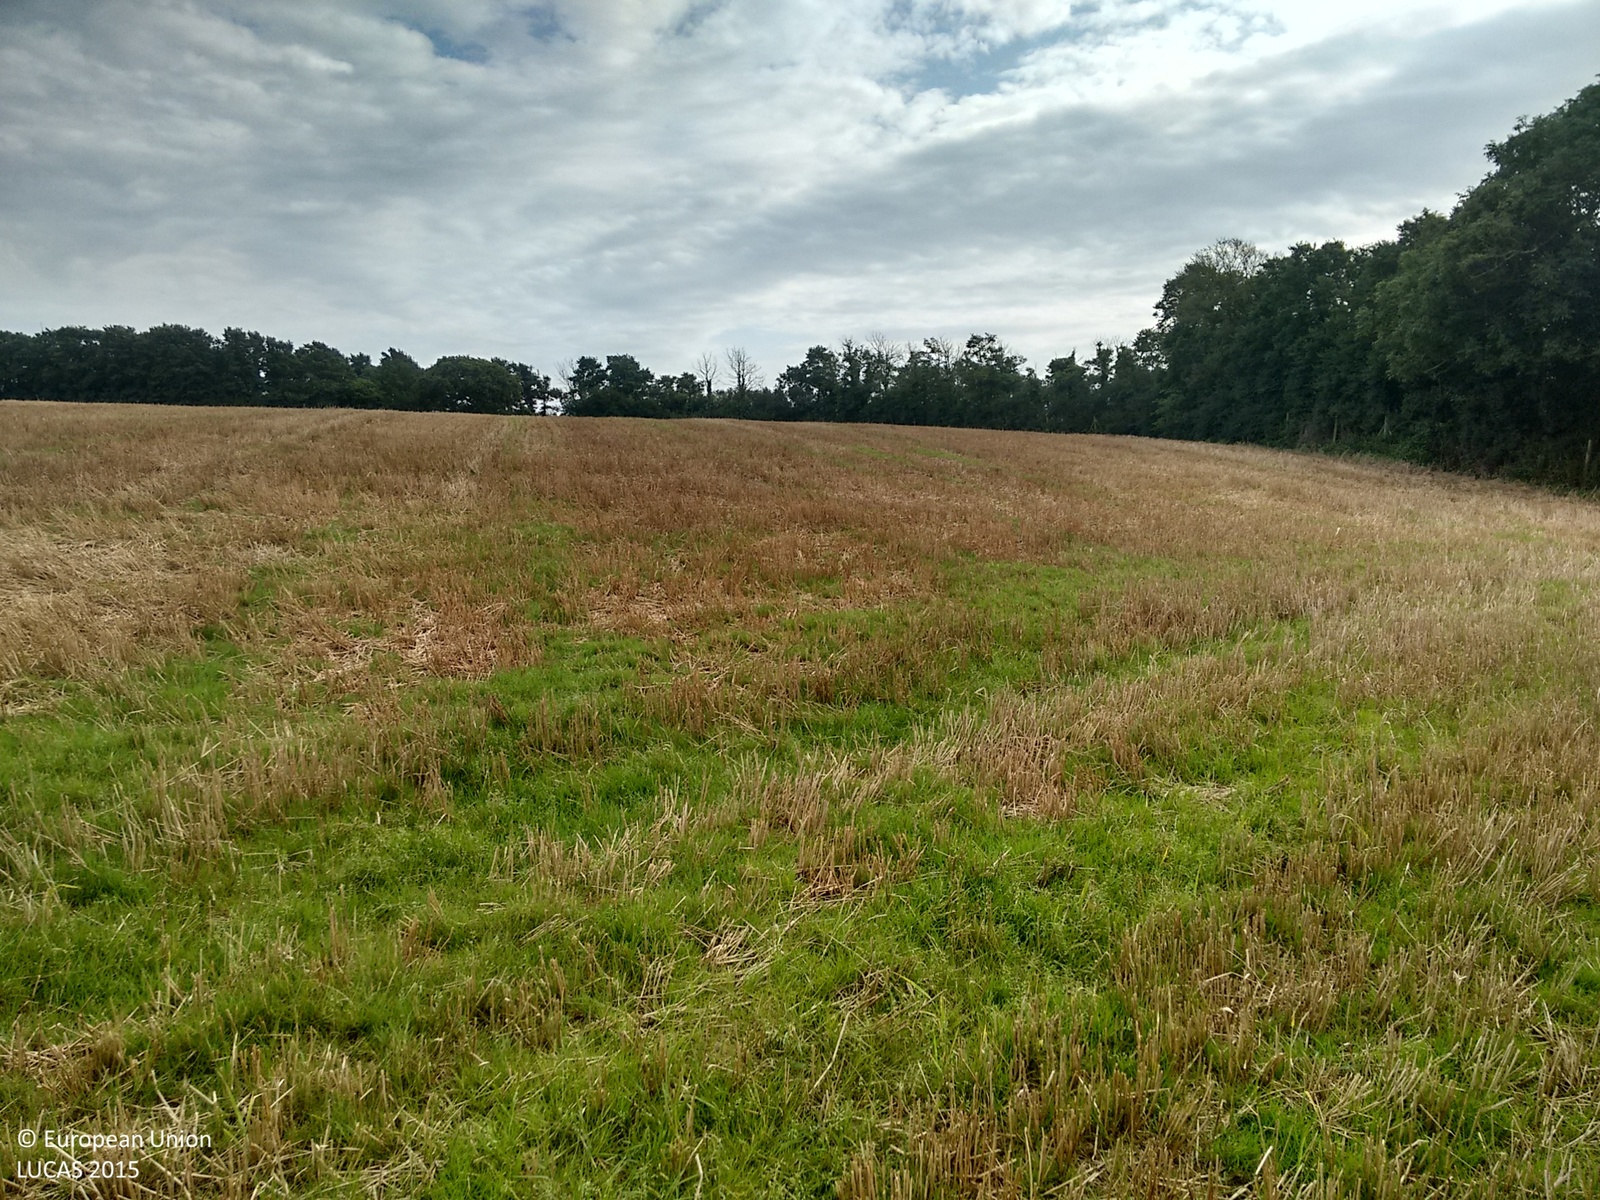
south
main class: Woodland
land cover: Broadleaved woodland
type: mesophytic deciduous forest
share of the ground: > 75 %
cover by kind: broadleaved forest trees 100 %
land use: Agriculture (excluding fallow land and kitchen gardens)
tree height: > 5 m
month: August
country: GB
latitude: 50.0655
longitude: -5.2509
